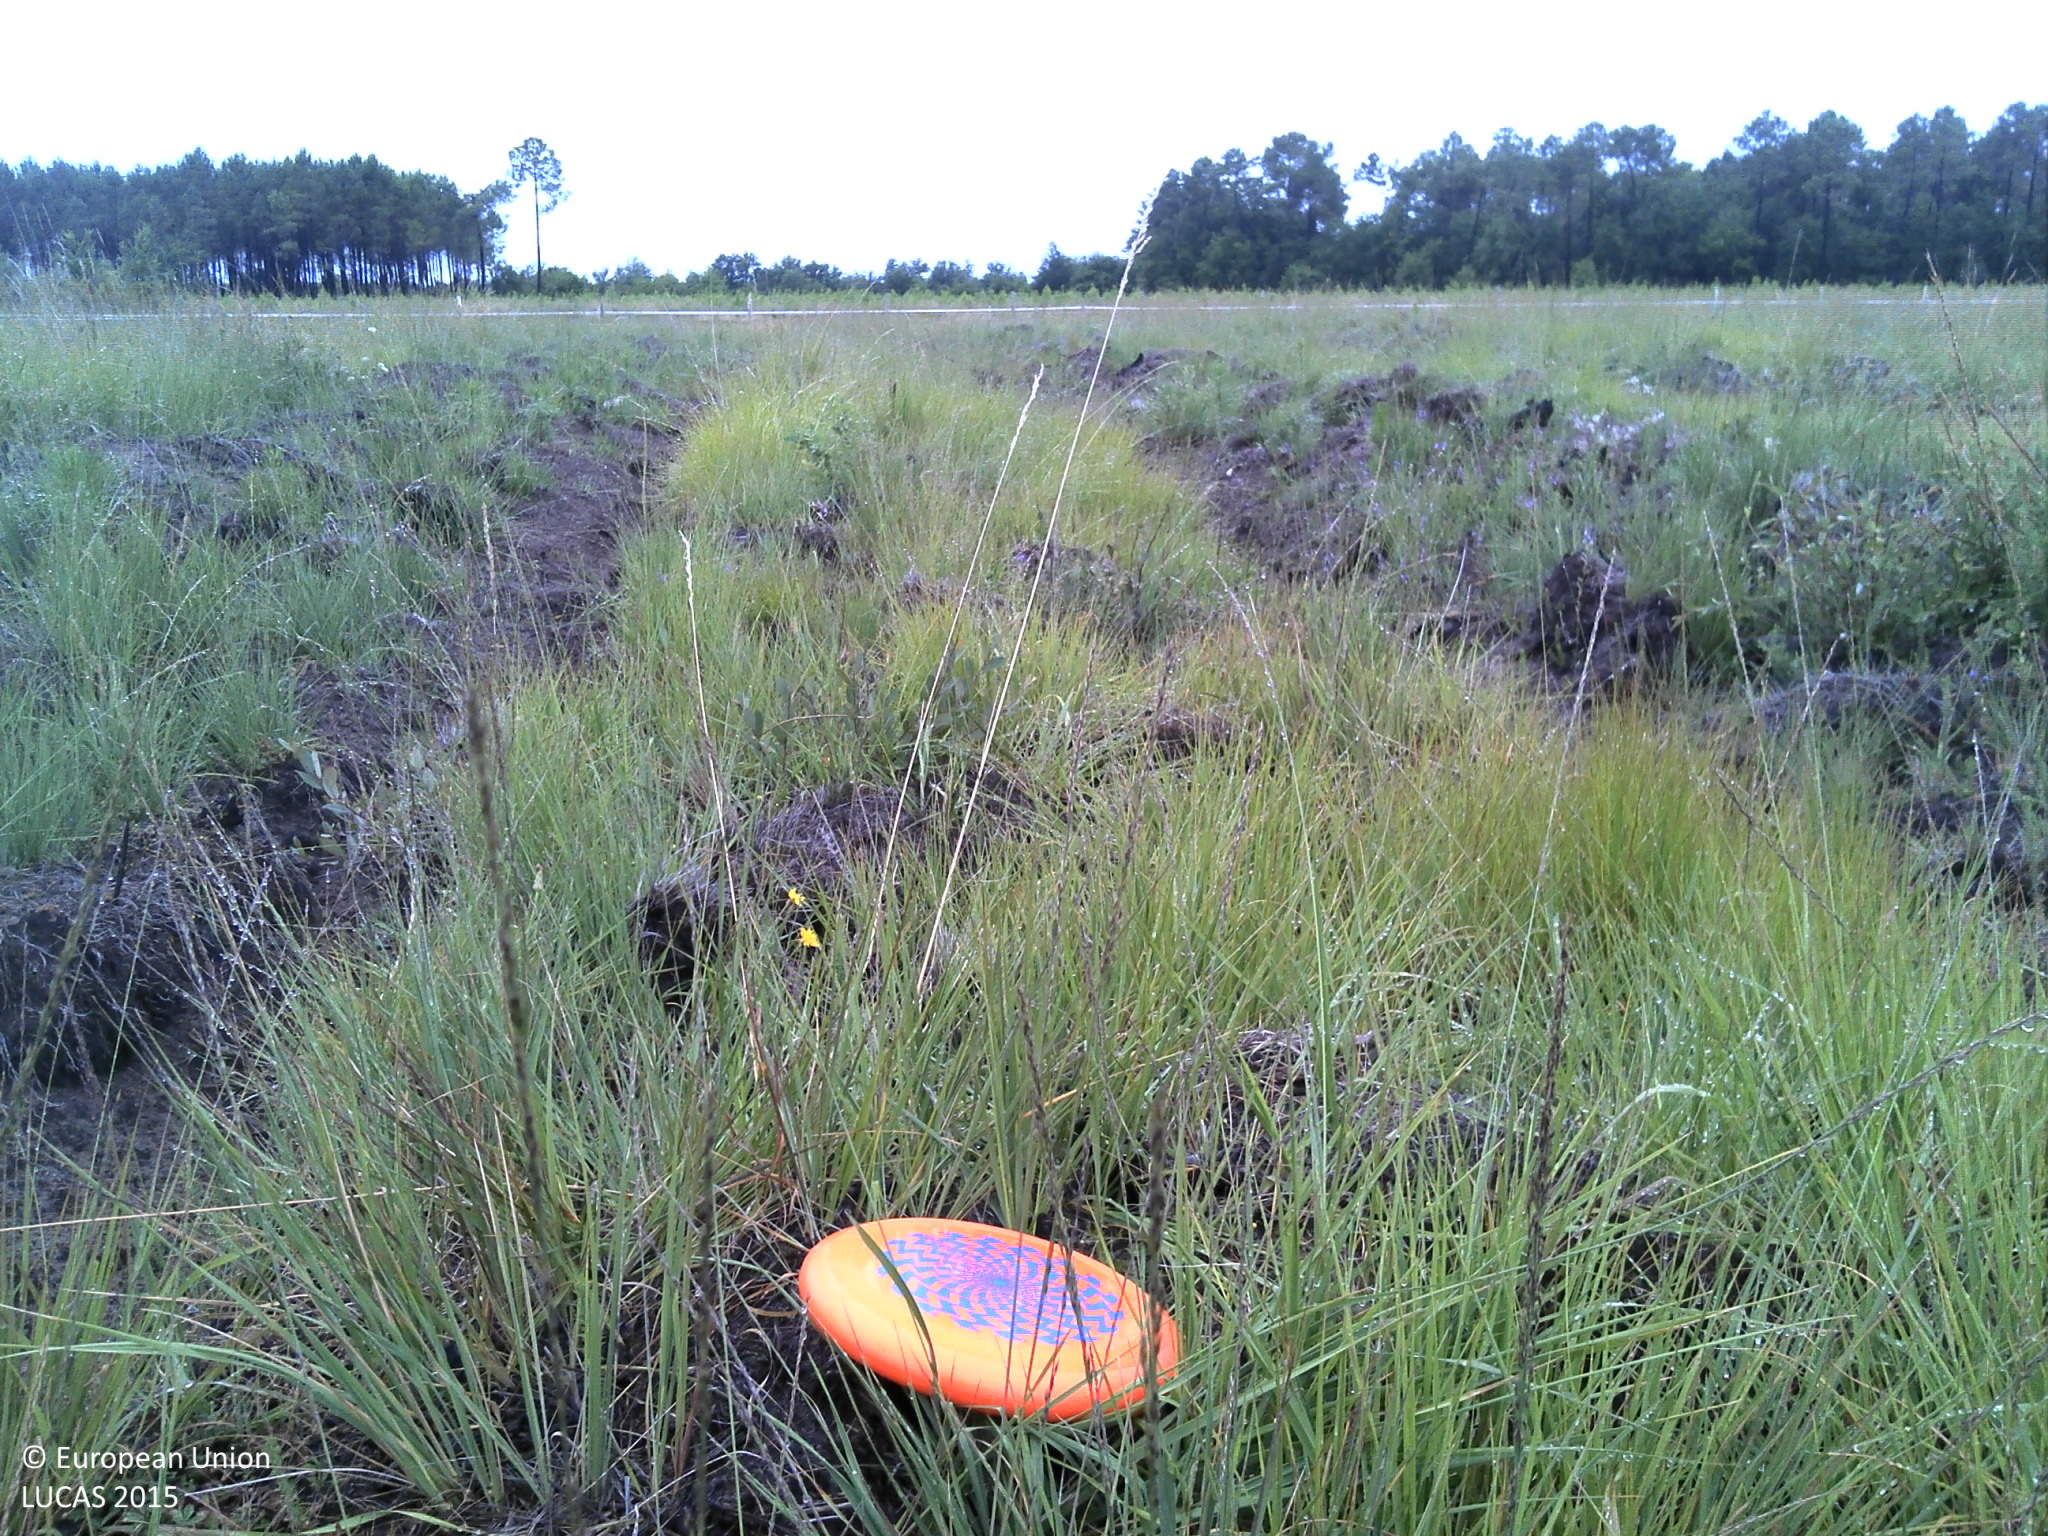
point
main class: Grassland
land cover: Spontaneously vegetated surfaces
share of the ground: > 75 %
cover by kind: herbaceous plants 95 %, shrubs 5 %
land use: Forestry
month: August
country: FR
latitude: 44.5859
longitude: -0.9662
